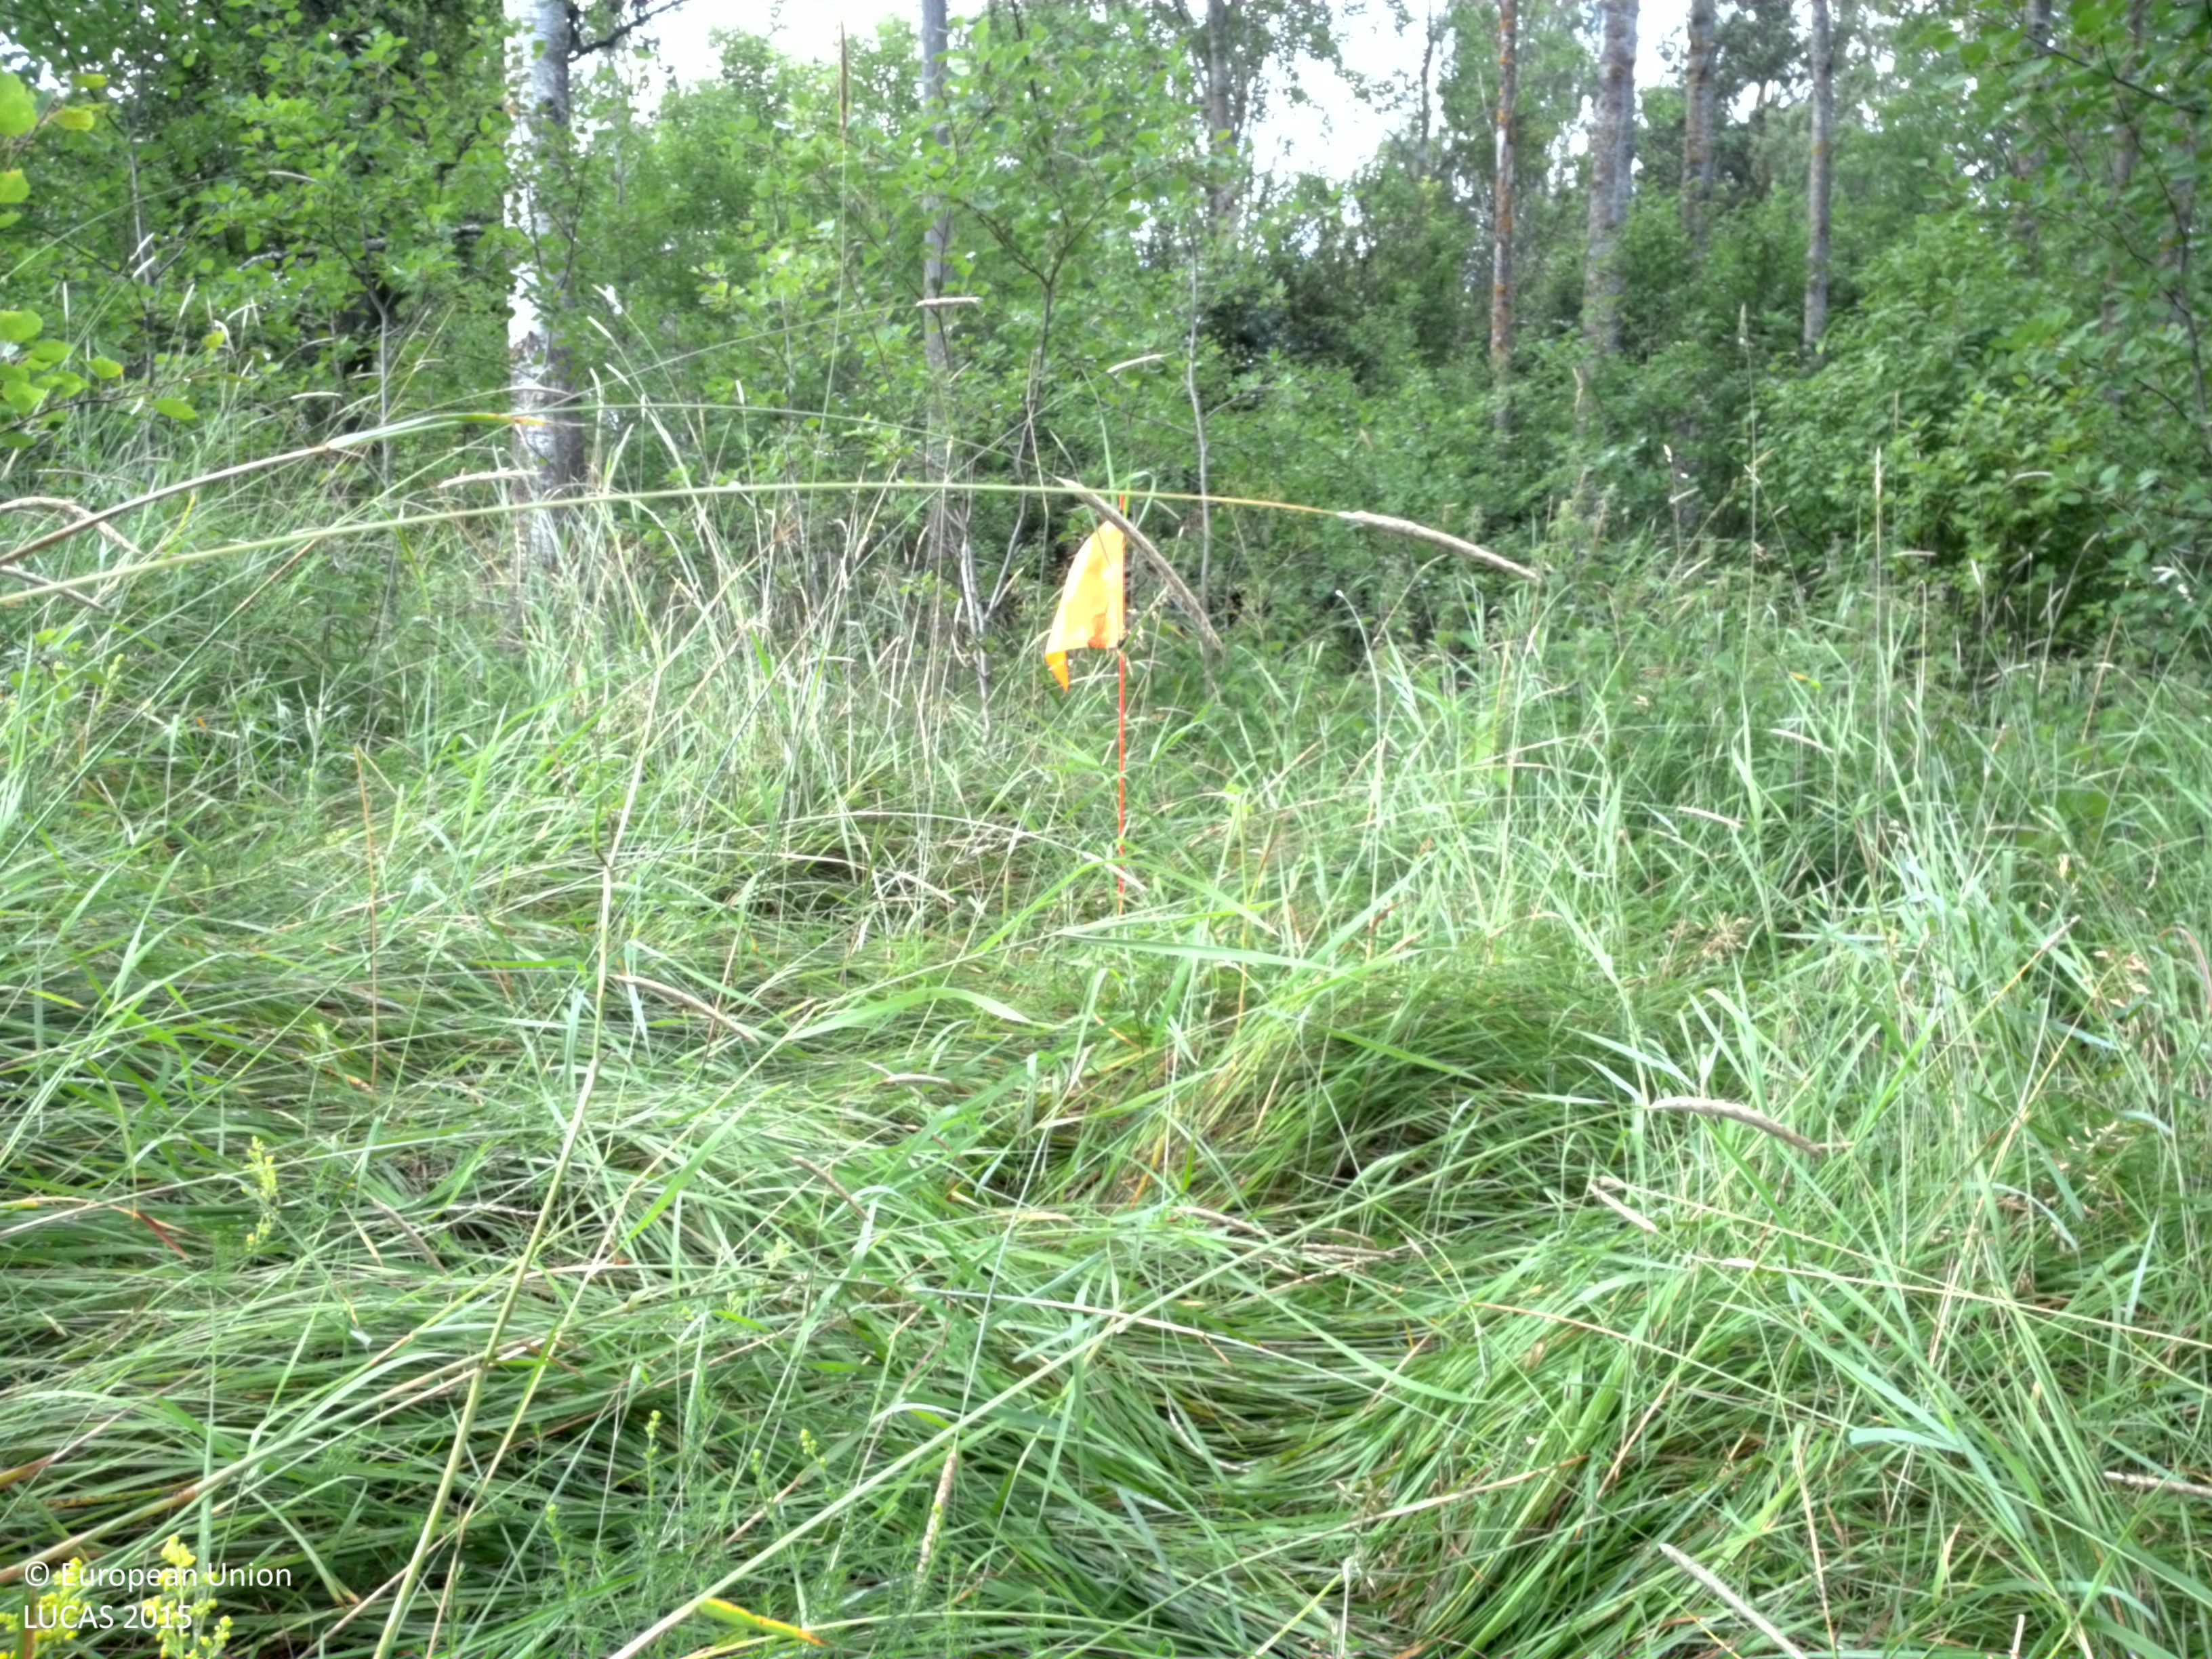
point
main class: Woodland
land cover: Broadleaved woodland
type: hemiboreal forest and nemoral coniferous forest and mixed broadleaved-coniferous forest
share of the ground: 25 - 50 %
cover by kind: broadleaved forest trees 50 %, herbaceous plants 50 %
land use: Semi-natural and natural areas not in use
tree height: > 5 m
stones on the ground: < 10 %
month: July
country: SE
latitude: 59.9734
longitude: 18.5799
